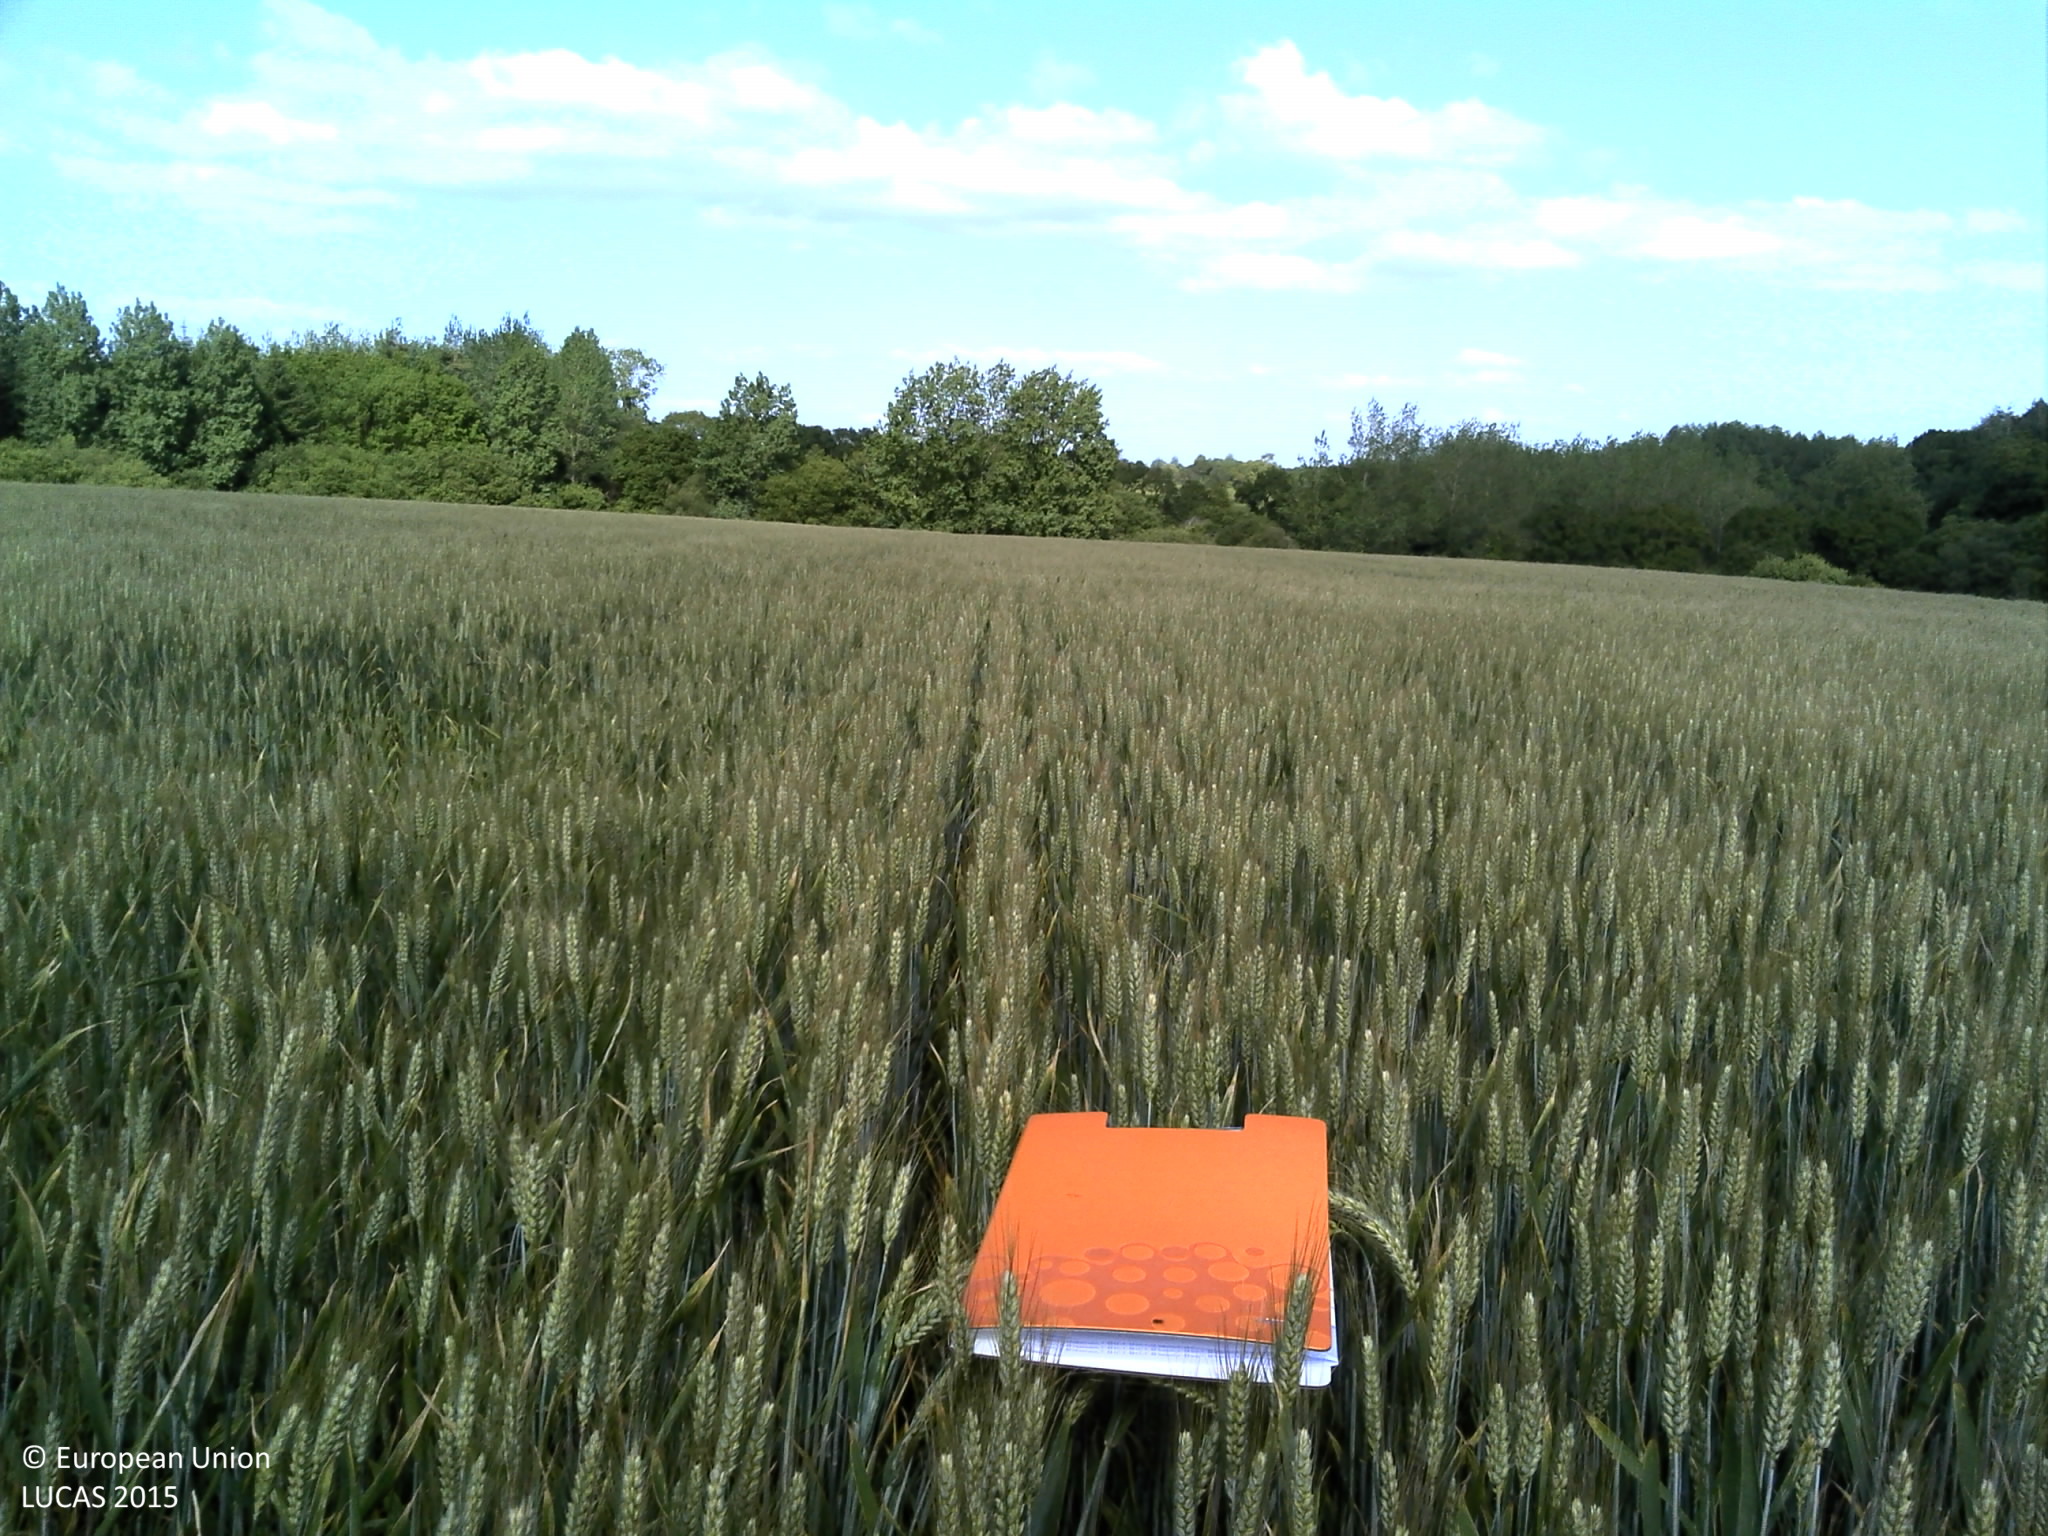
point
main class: Cropland
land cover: Common wheat
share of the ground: > 75 %
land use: Agriculture (excluding fallow land and kitchen gardens)
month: June
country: FR
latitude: 48.0738
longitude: -4.4161
